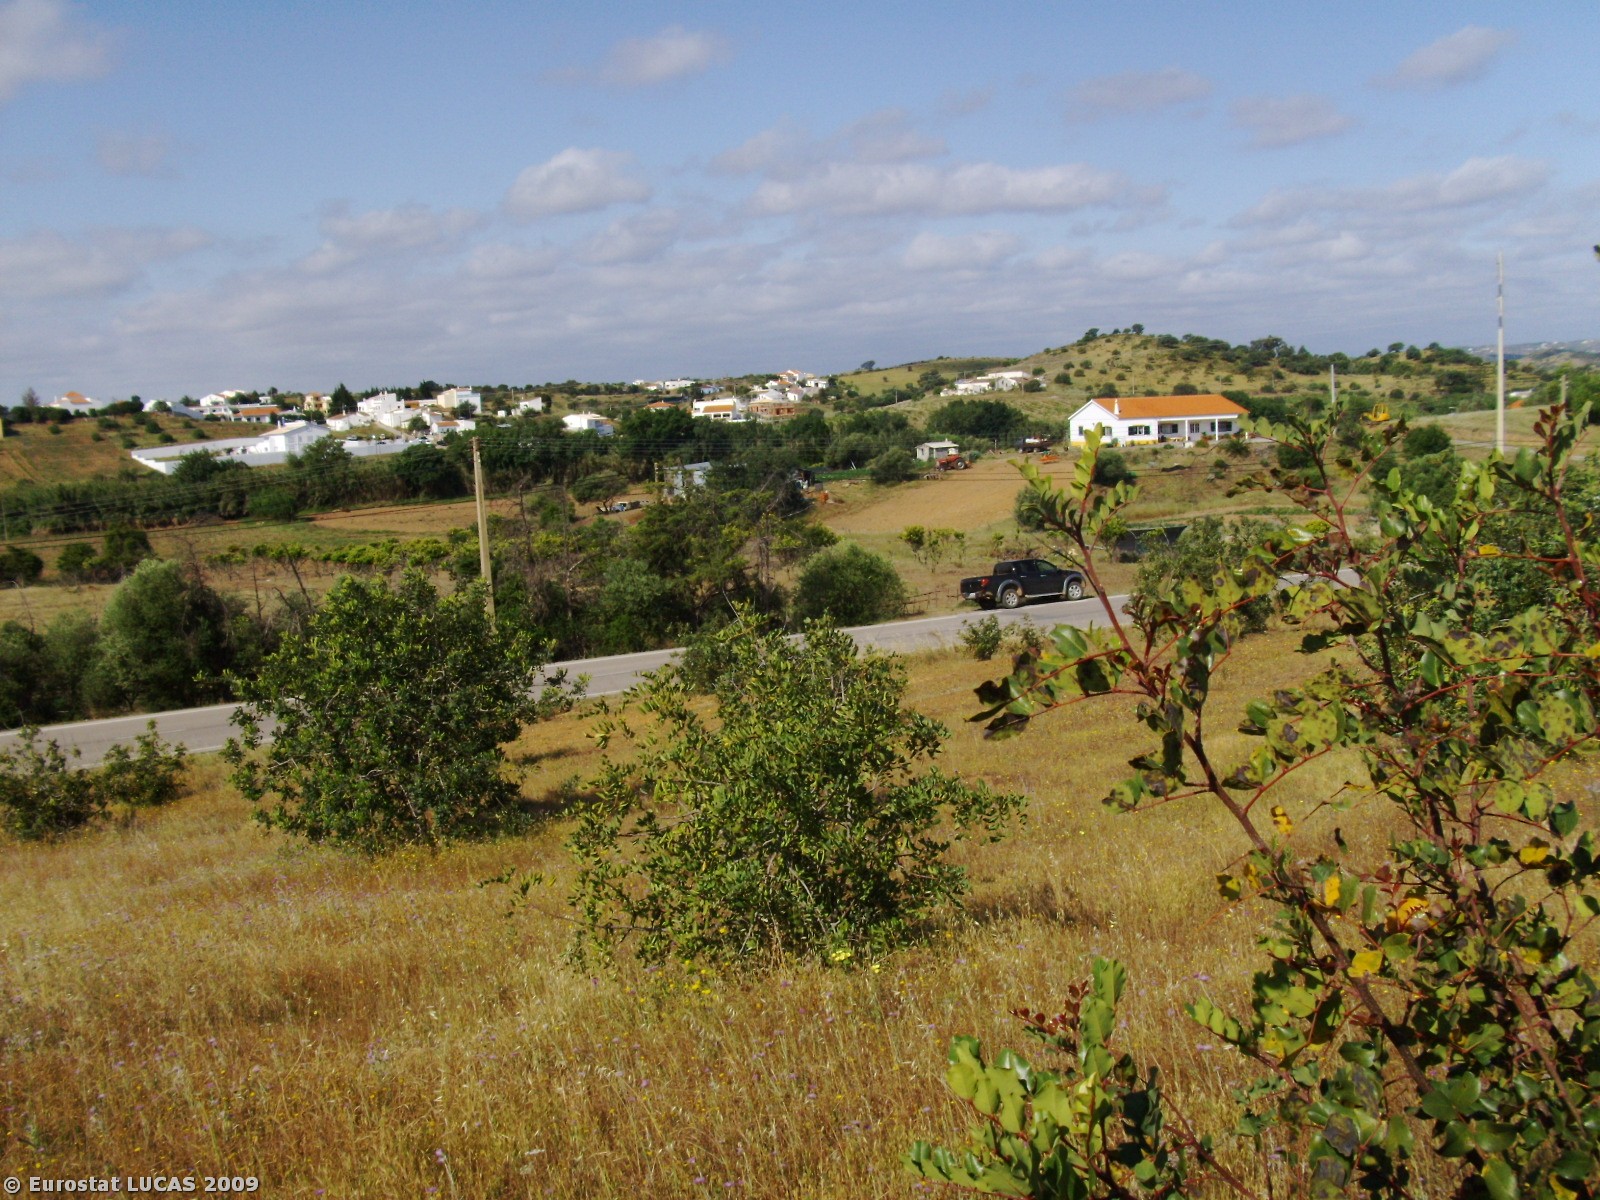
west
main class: Cropland
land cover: Permanent industrial crops
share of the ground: 10 - 25 %
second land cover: Spontaneously vegetated surfaces
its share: > 75 %
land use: Agriculture (excluding fallow land and kitchen gardens)
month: April
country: PT
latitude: 37.2240
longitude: -7.4833
